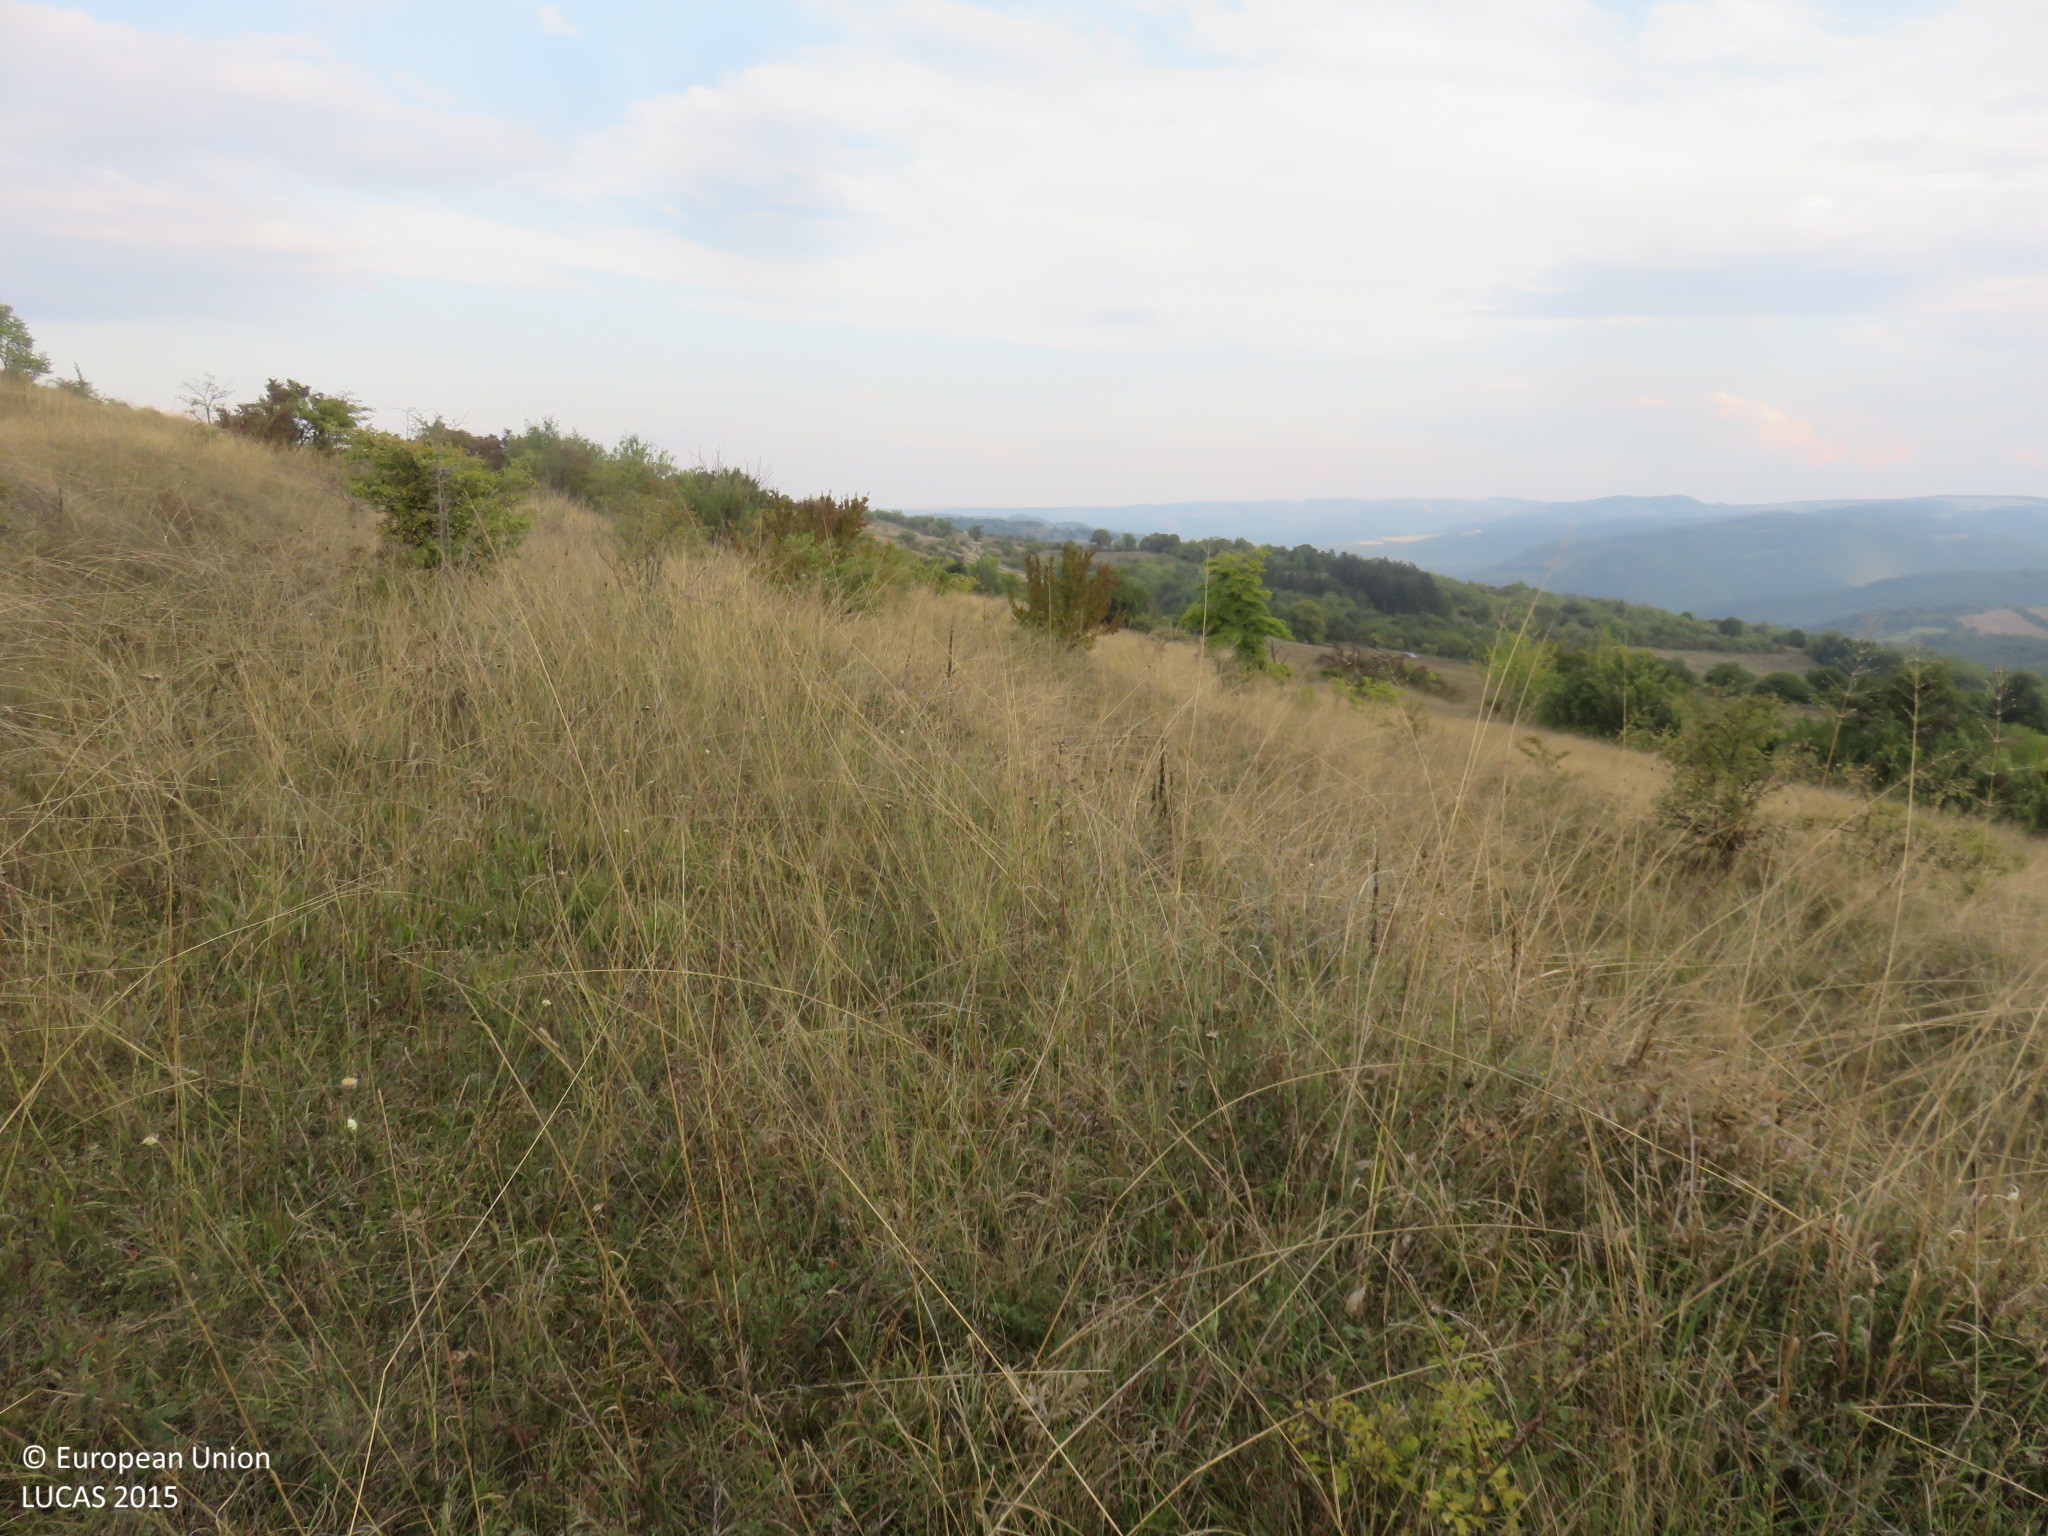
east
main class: Grassland
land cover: Grassland with sparse tree/shrub cover
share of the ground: > 75 %
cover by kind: herbaceous plants 90 %, broadleaved forest trees 5 %, shrubs 5 %
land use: Semi-natural and natural areas not in use
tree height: < 5 m
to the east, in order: Grassland with sparse tree/shrub cover; Shrubland with sparse tree cover; Grassland with sparse tree/shrub cover; Grassland without tree/shrub cover
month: September
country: BG
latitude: 43.1032
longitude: 25.0210
